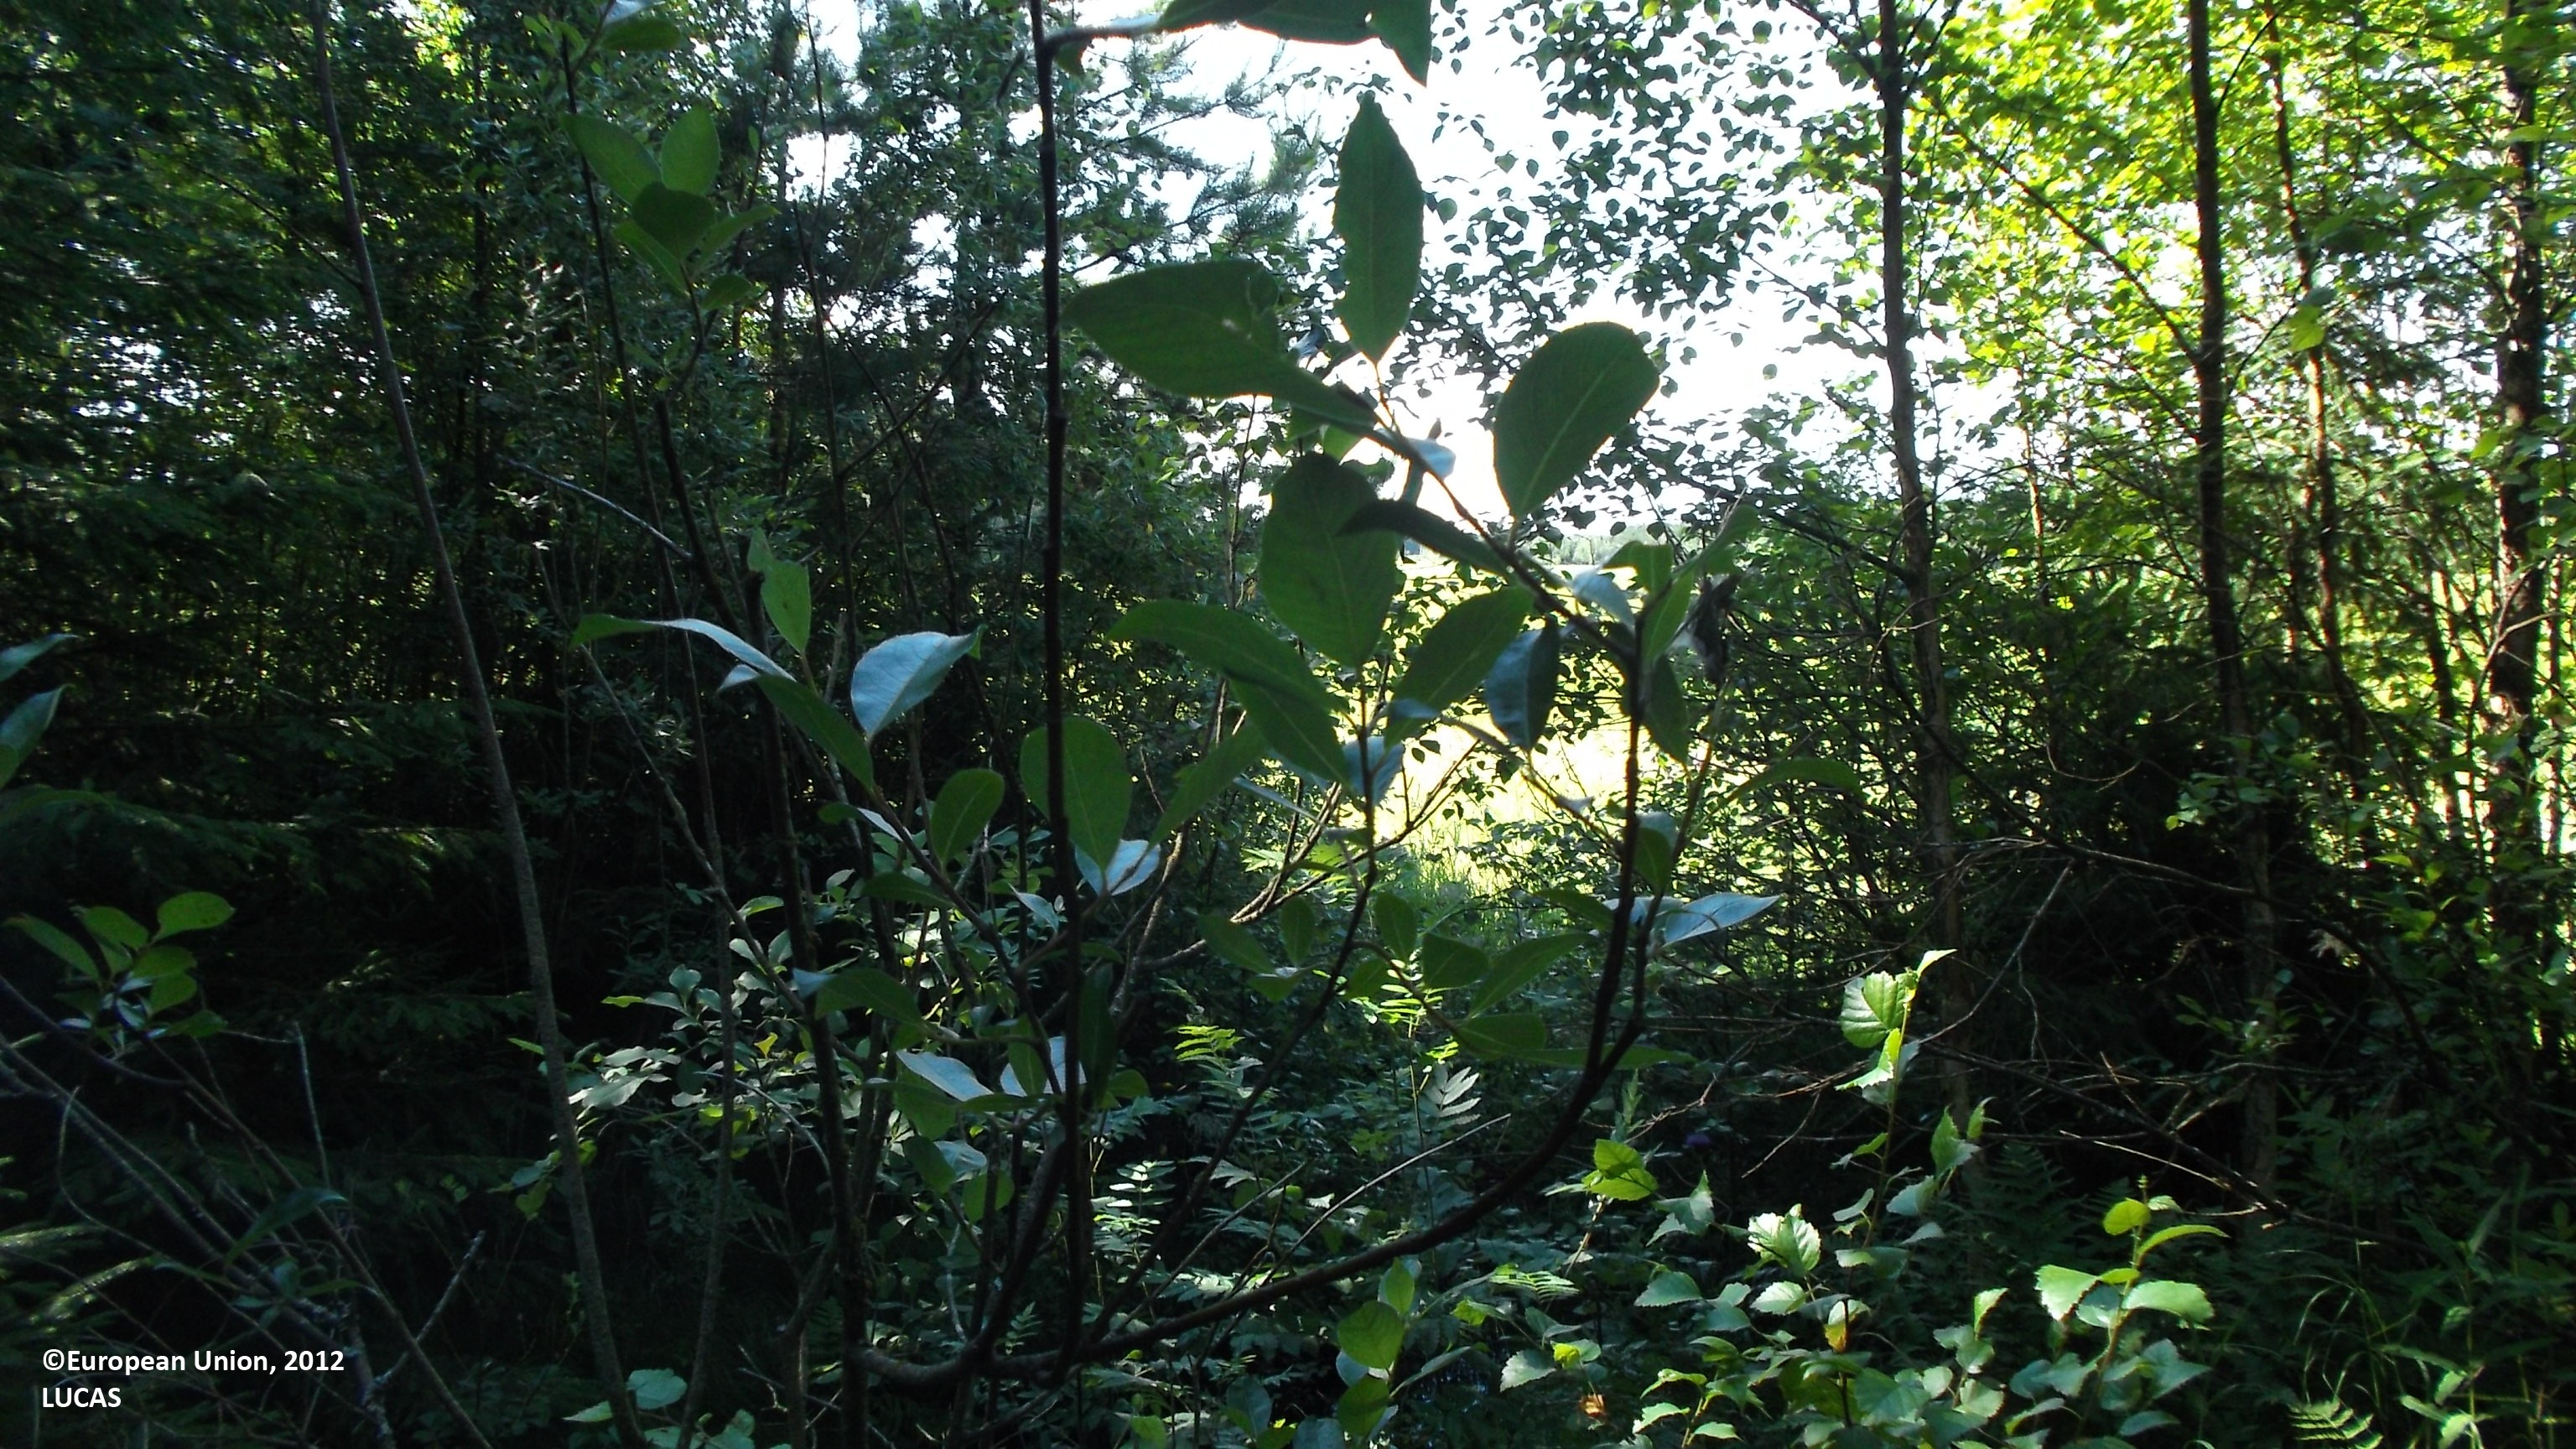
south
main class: Woodland
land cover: Spruce dominated mixed woodland
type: boreal forest
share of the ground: 50 - 75 %
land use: Forestry
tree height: > 5 m
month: July
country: FI
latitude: 63.6445
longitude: 22.9535
